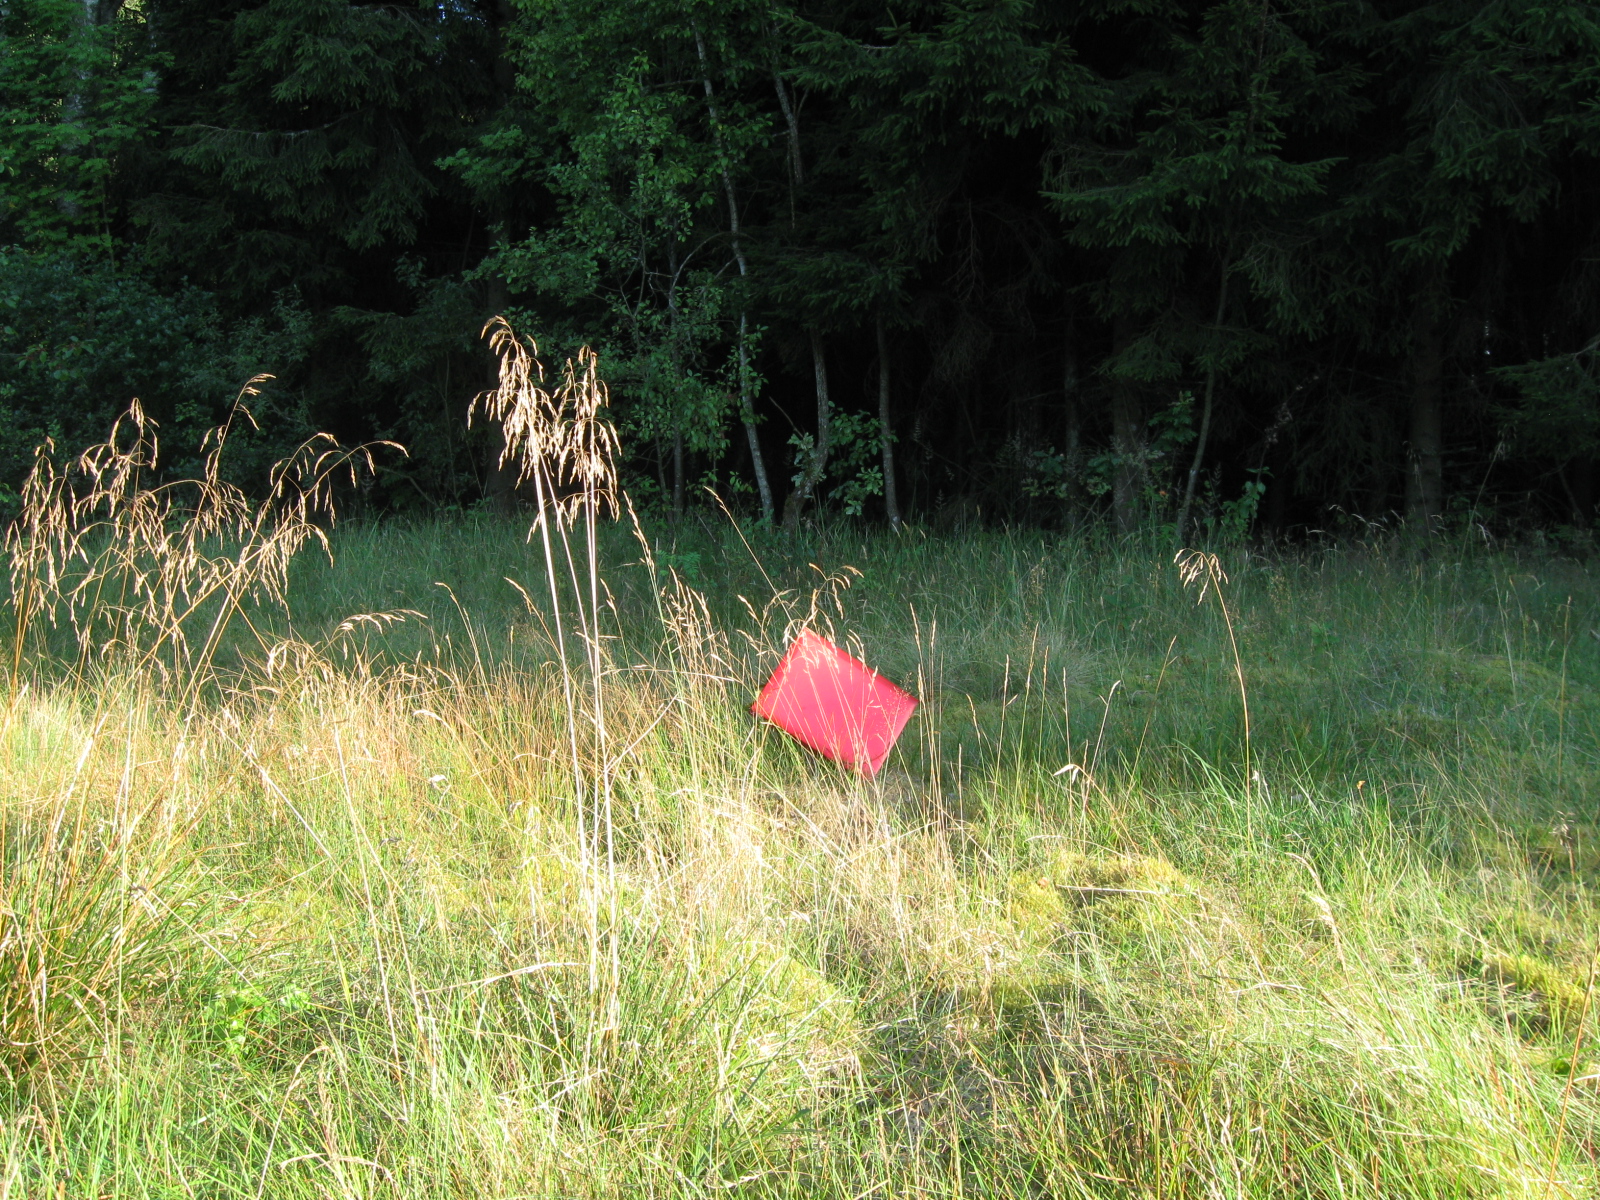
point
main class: Grassland
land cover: Grassland with sparse tree/shrub cover
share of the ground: > 75 %
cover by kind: herbaceous plants 75 %, lichens and mosses 15 %, broadleaved forest trees 5 %, shrubs 5 %
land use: Semi-natural and natural areas not in use
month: August
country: LT
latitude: 54.8184
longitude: 23.4485
